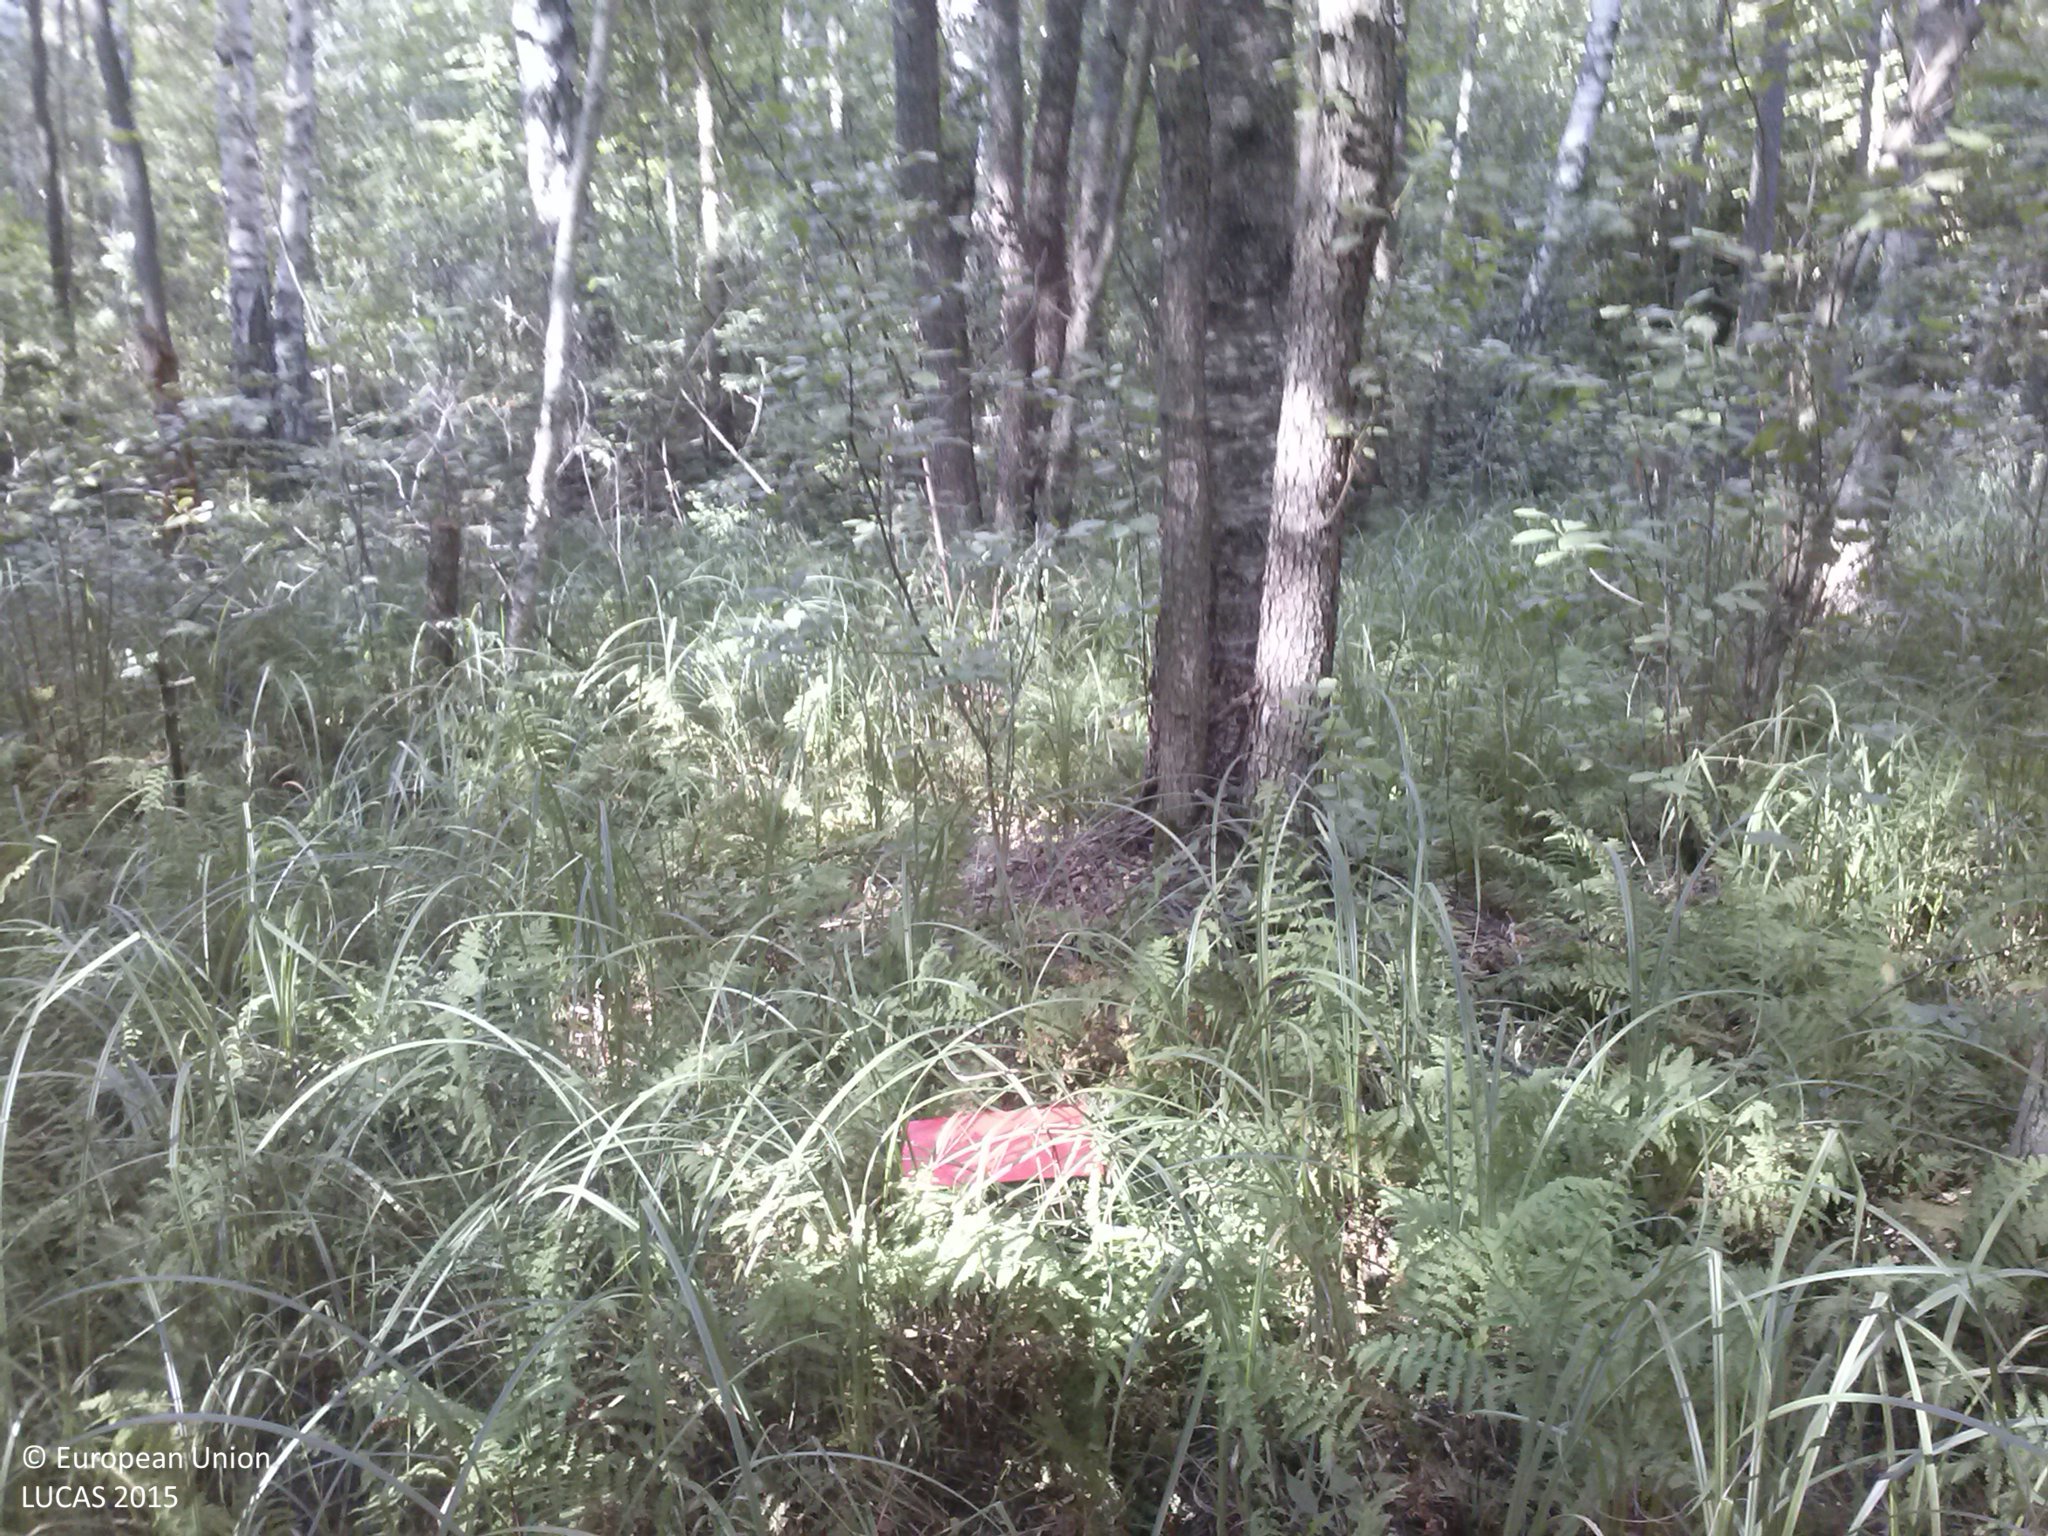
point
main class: Woodland
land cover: Broadleaved woodland
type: non-riverine alder, birch or aspen forest
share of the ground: > 75 %
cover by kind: broadleaved forest trees 75 %, herbaceous plants 25 %
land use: Forestry
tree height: > 5 m
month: August
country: LV
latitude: 56.1651
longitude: 26.8596
